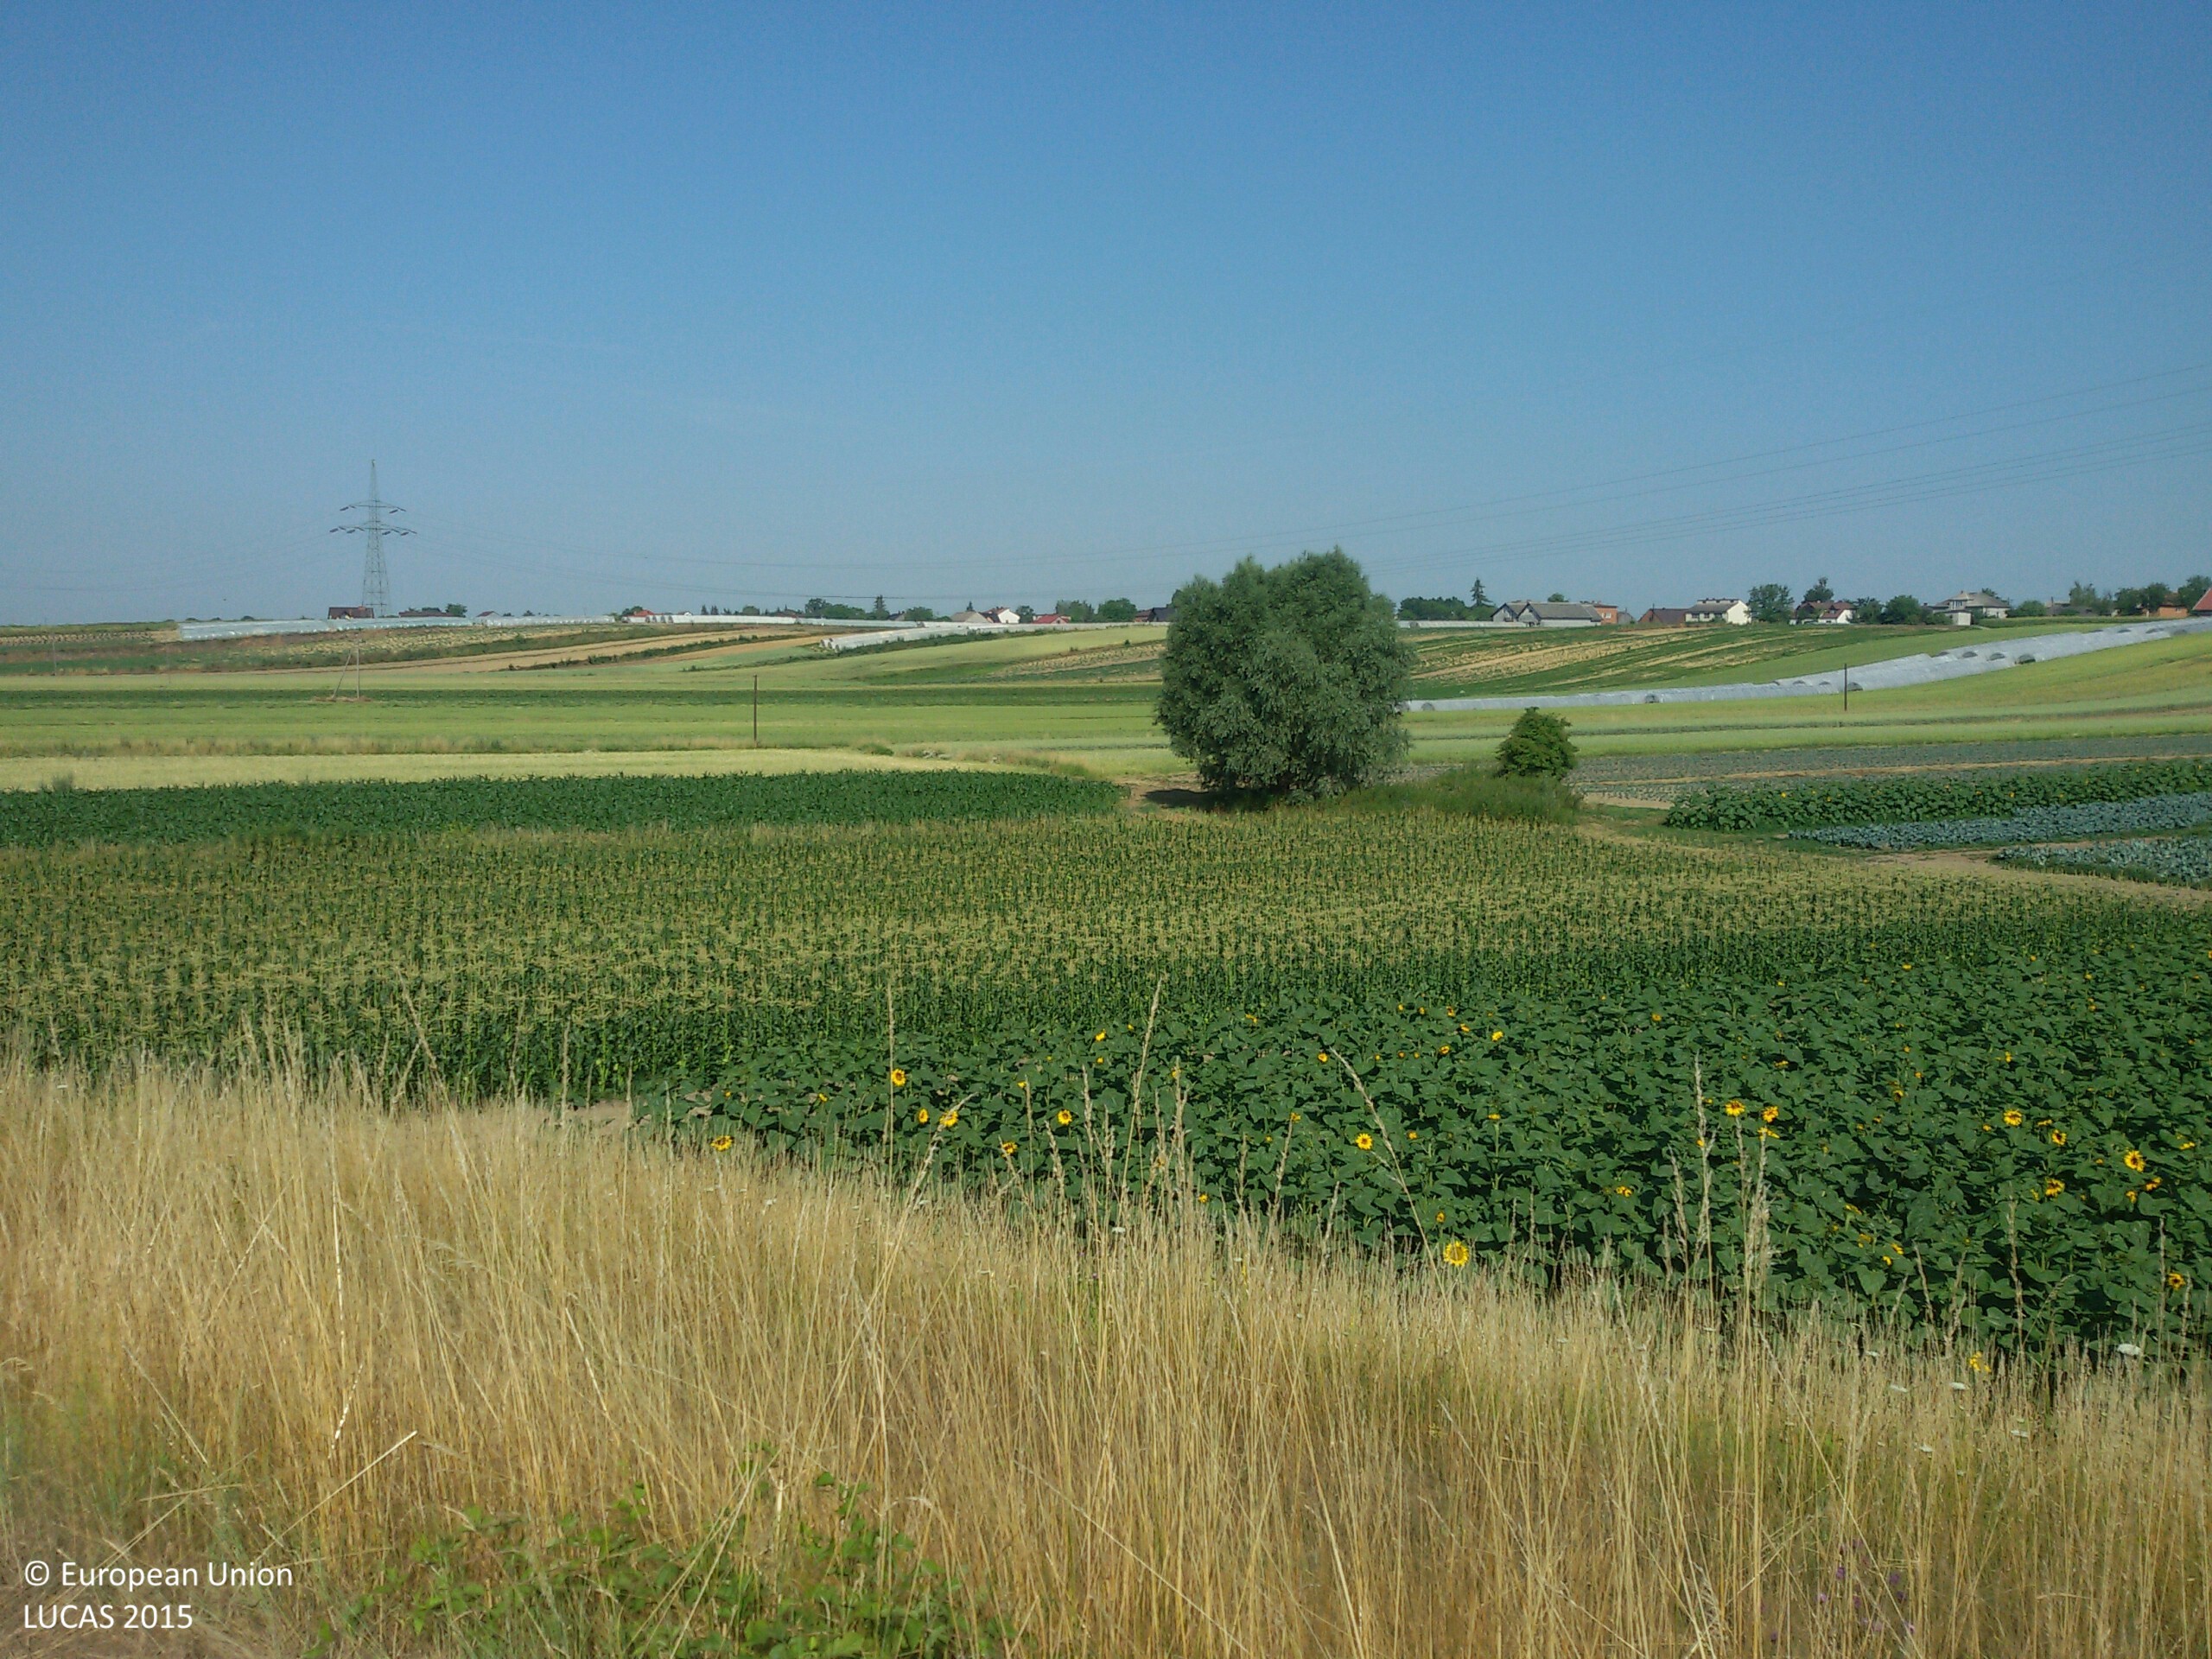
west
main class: Grassland
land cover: Spontaneously vegetated surfaces
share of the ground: > 75 %
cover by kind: herbaceous plants 100 %
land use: Semi-natural and natural areas not in use
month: July
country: PL
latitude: 50.1116
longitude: 20.3418
